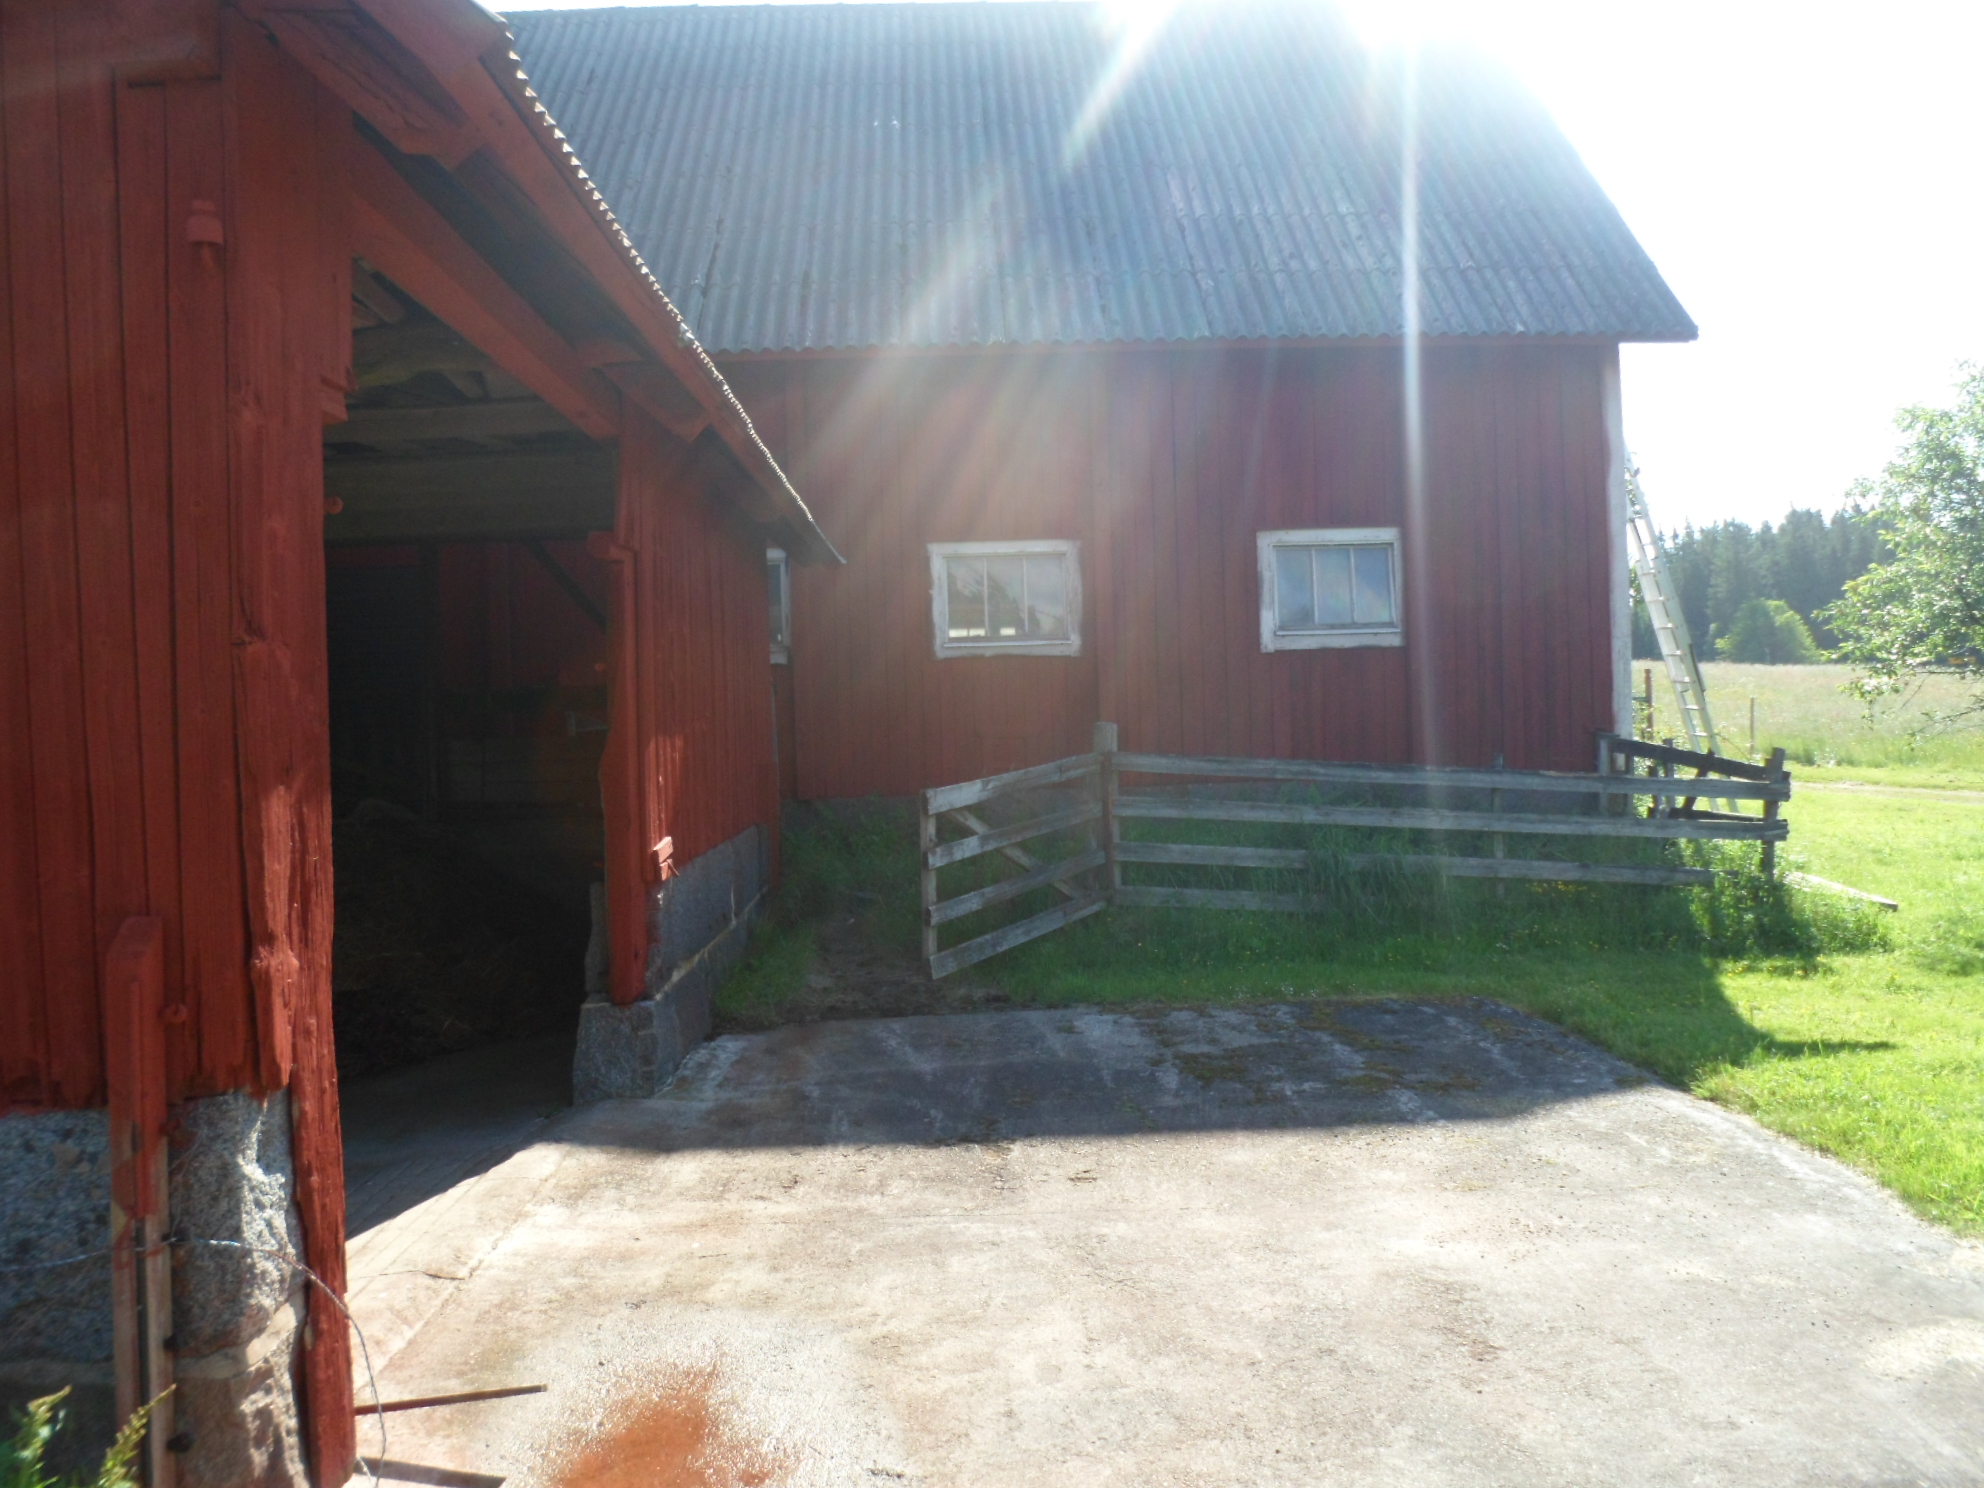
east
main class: Grassland
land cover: Grassland without tree/shrub cover
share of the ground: > 75 %
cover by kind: herbaceous plants 100 %
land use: Agriculture (excluding fallow land and kitchen gardens)
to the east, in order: Grassland without tree/shrub cover; Artificial constructions in urban areas; Ditches and canals; Paved roads, cycling and walking lanes; Grassland with sparse tree/shrub cover; Broadleaved woodland; Spruce dominated mixed woodland; Broadleaved woodland
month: June
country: SE
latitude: 57.1223
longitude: 14.8692
